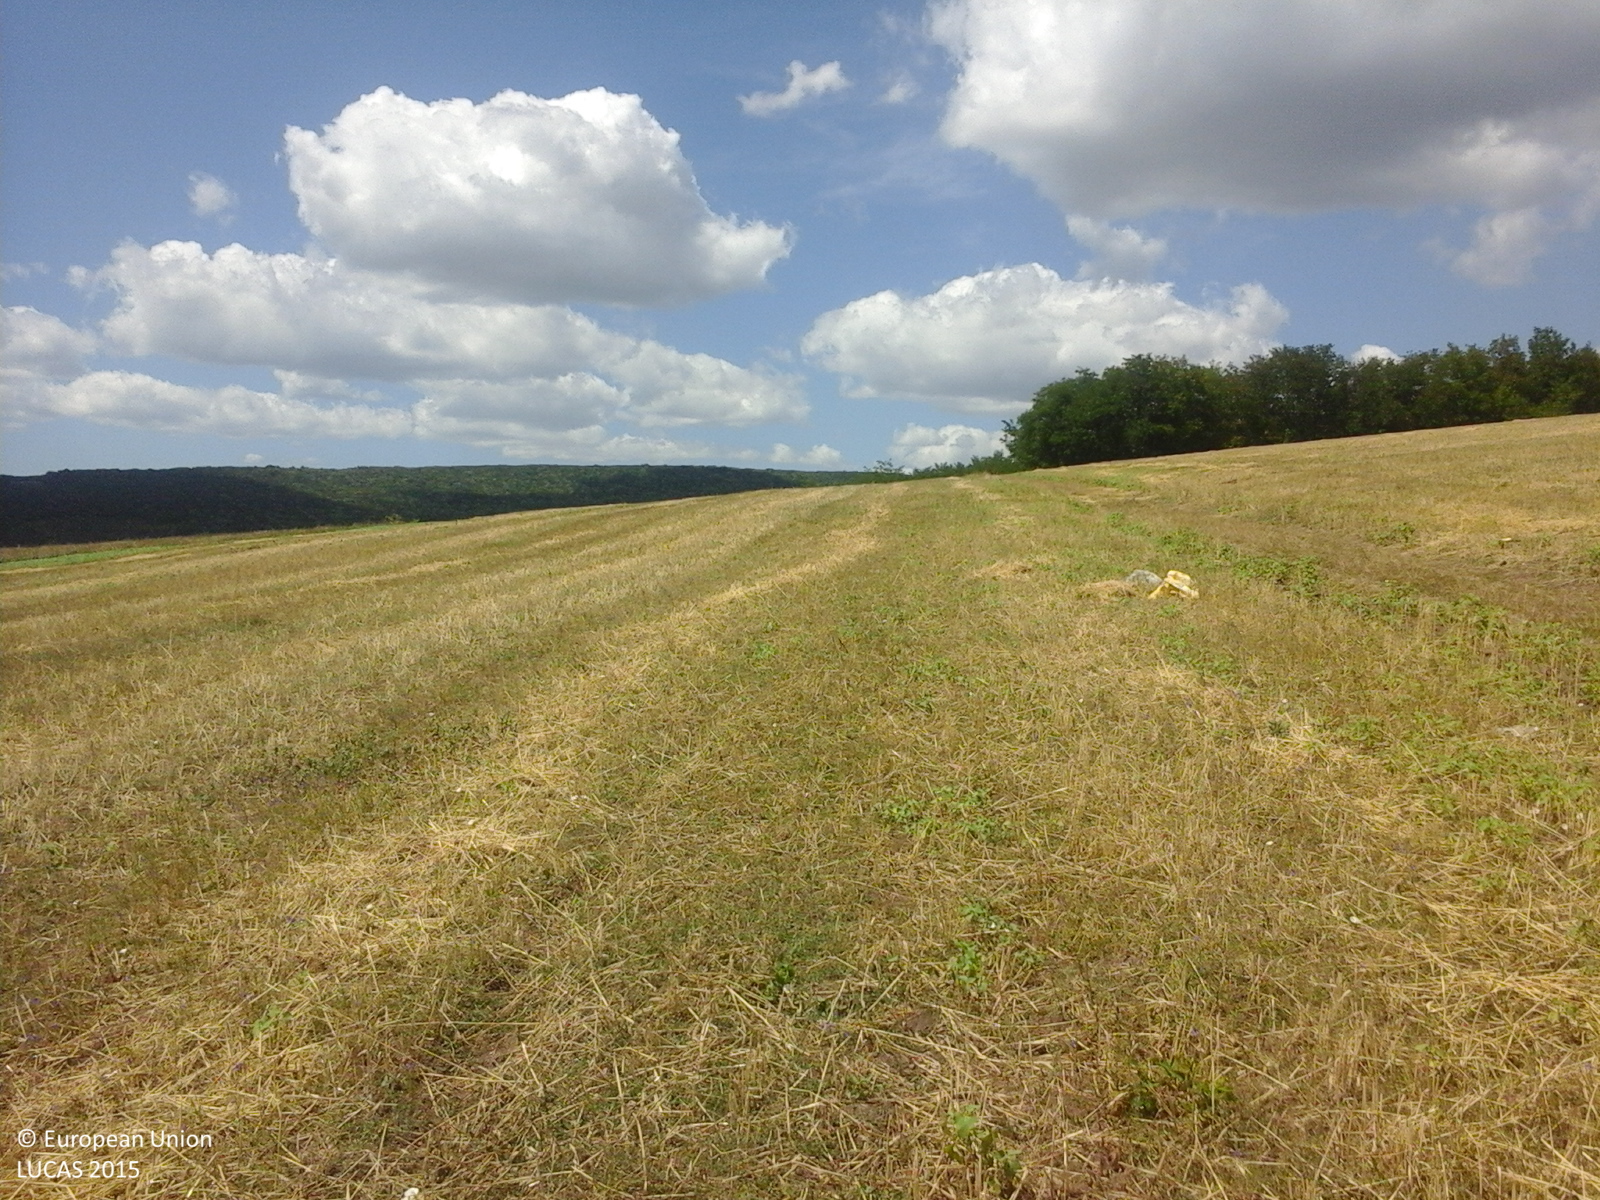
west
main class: Cropland
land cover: Common wheat
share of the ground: > 75 %
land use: Agriculture (excluding fallow land and kitchen gardens)
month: July
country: RO
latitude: 46.4205
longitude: 27.3991
